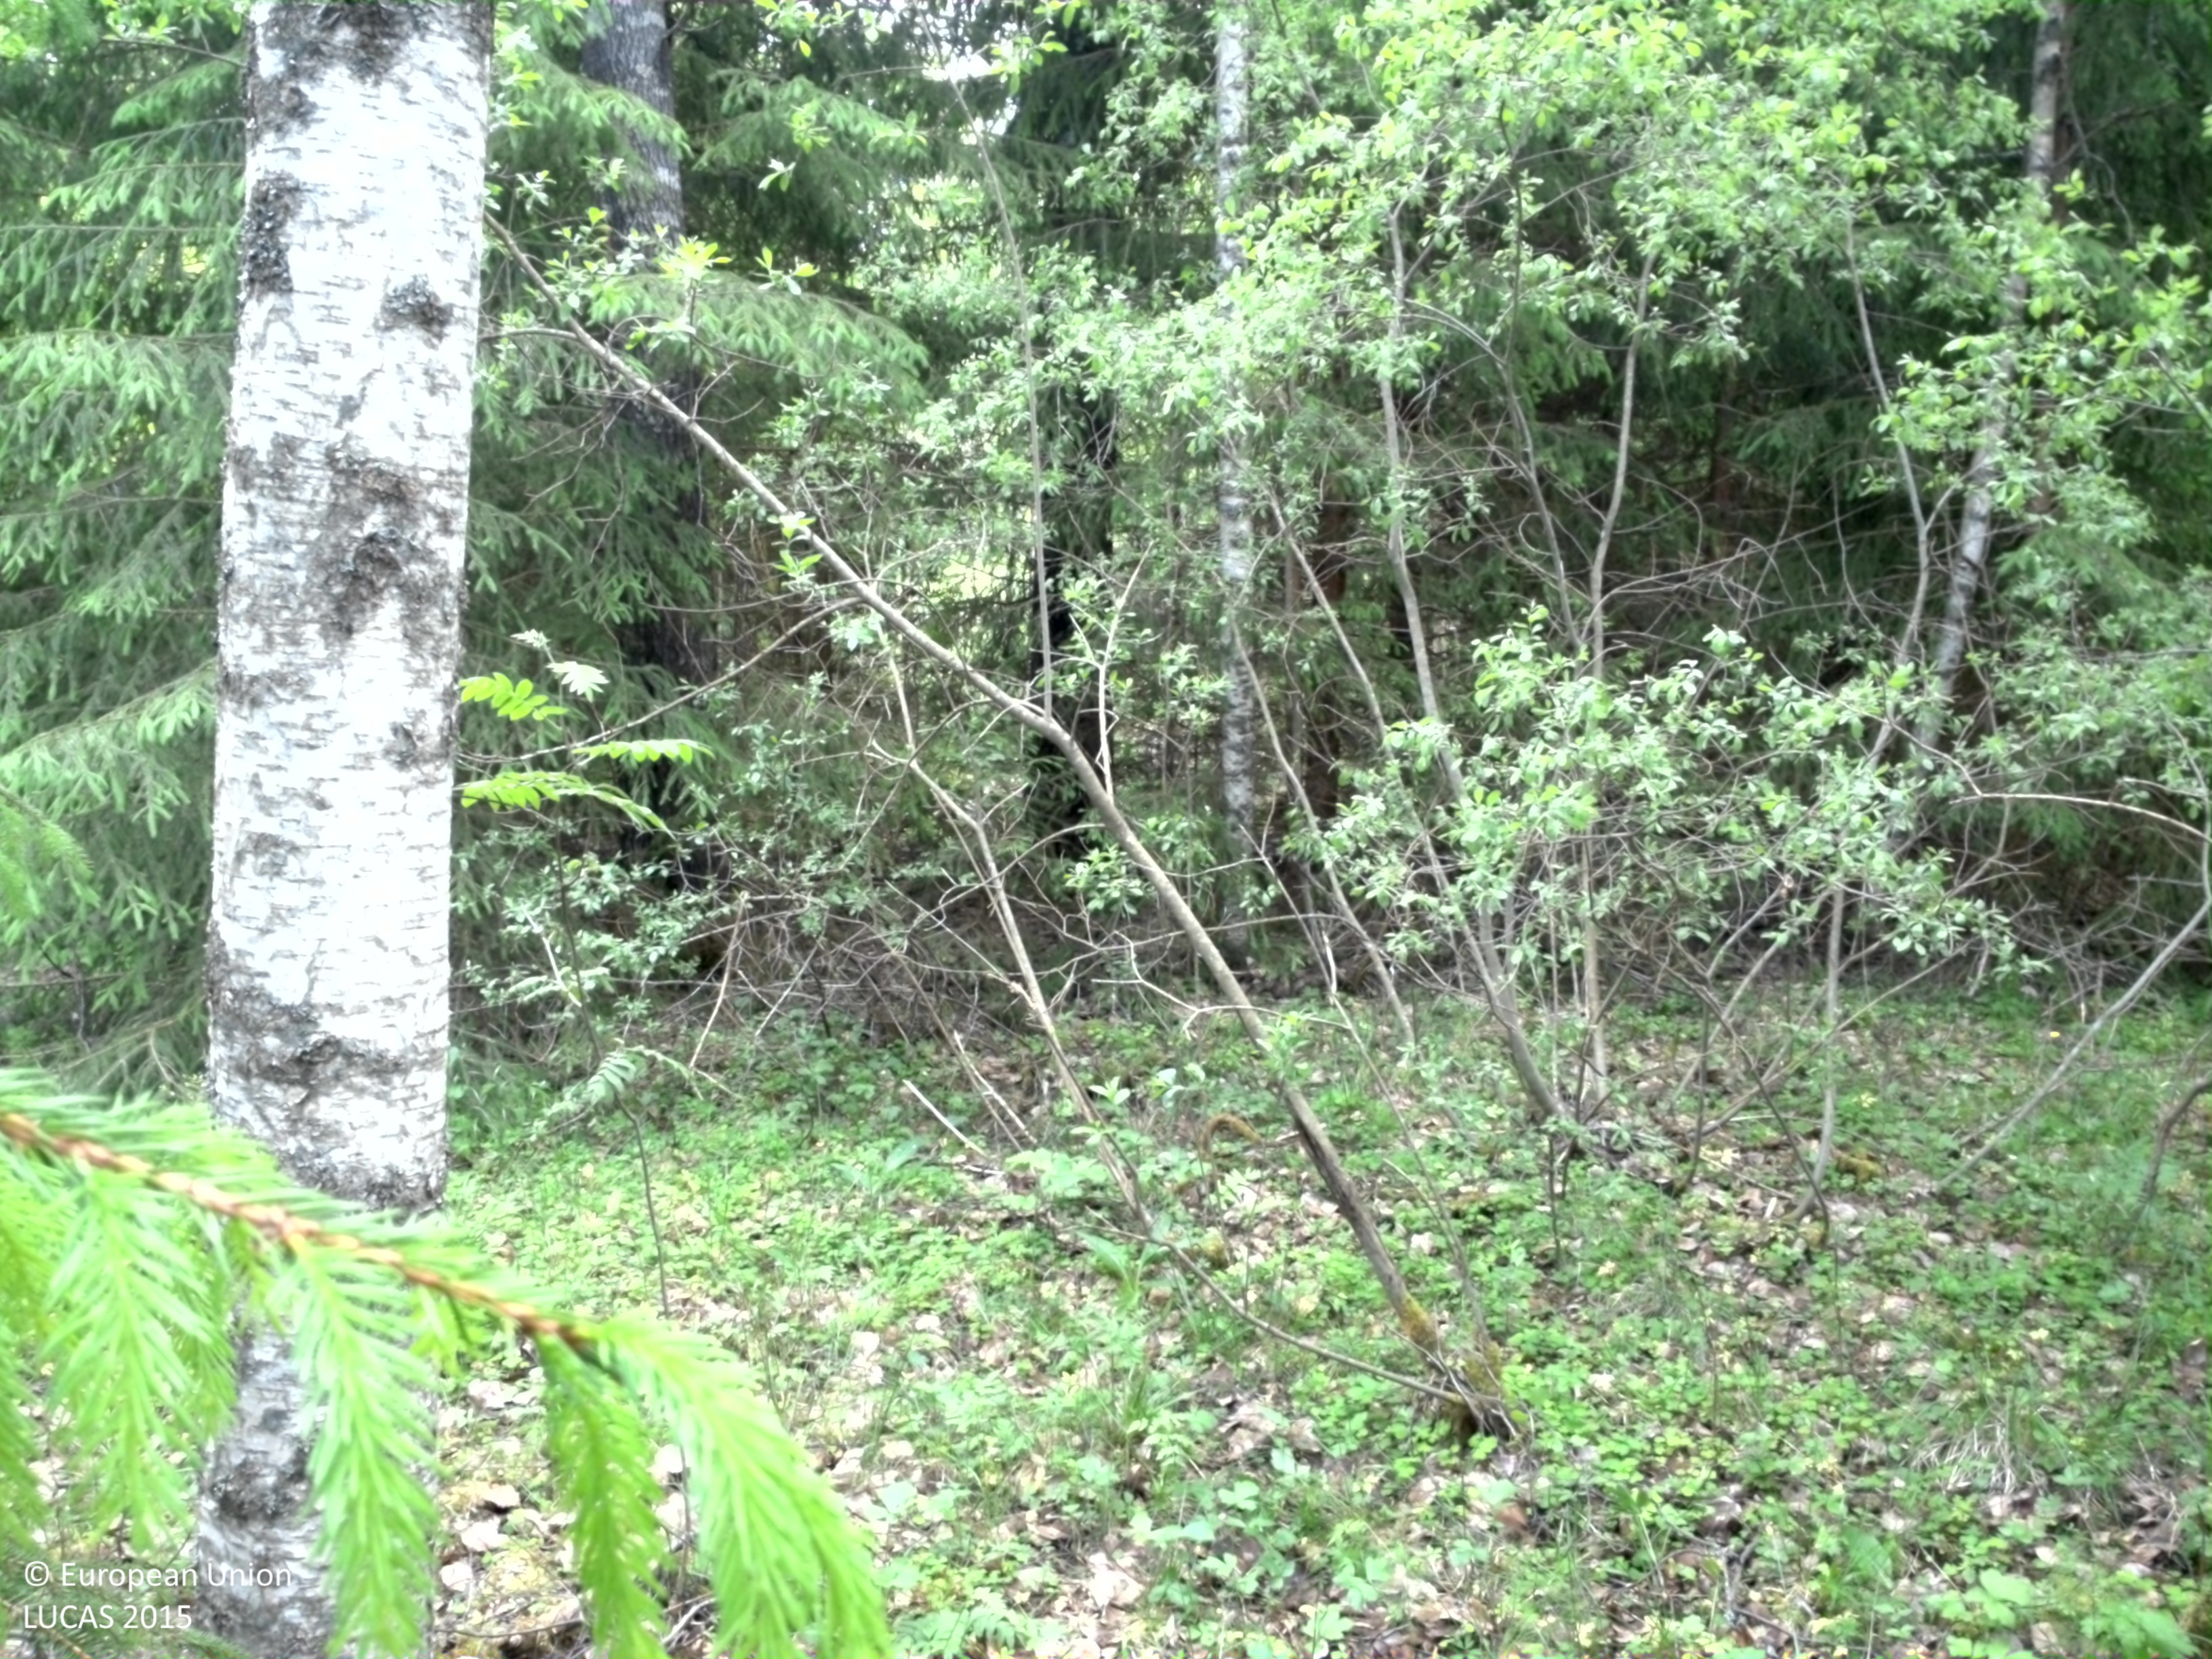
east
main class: Woodland
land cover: Spruce dominated mixed woodland
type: boreal forest
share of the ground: 50 - 75 %
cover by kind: broadleaved forest trees 50 %, coniferous forest trees 20 %, shrubs 15 %, herbaceous plants 15 %
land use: Forestry
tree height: > 5 m
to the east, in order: Spruce dominated mixed woodland; Tracks; Spruce dominated mixed woodland; Spruce dominated coniferous woodland; Ditches and canals; Grassland without tree/shrub cover
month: June
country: SE
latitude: 59.5239
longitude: 14.1805
